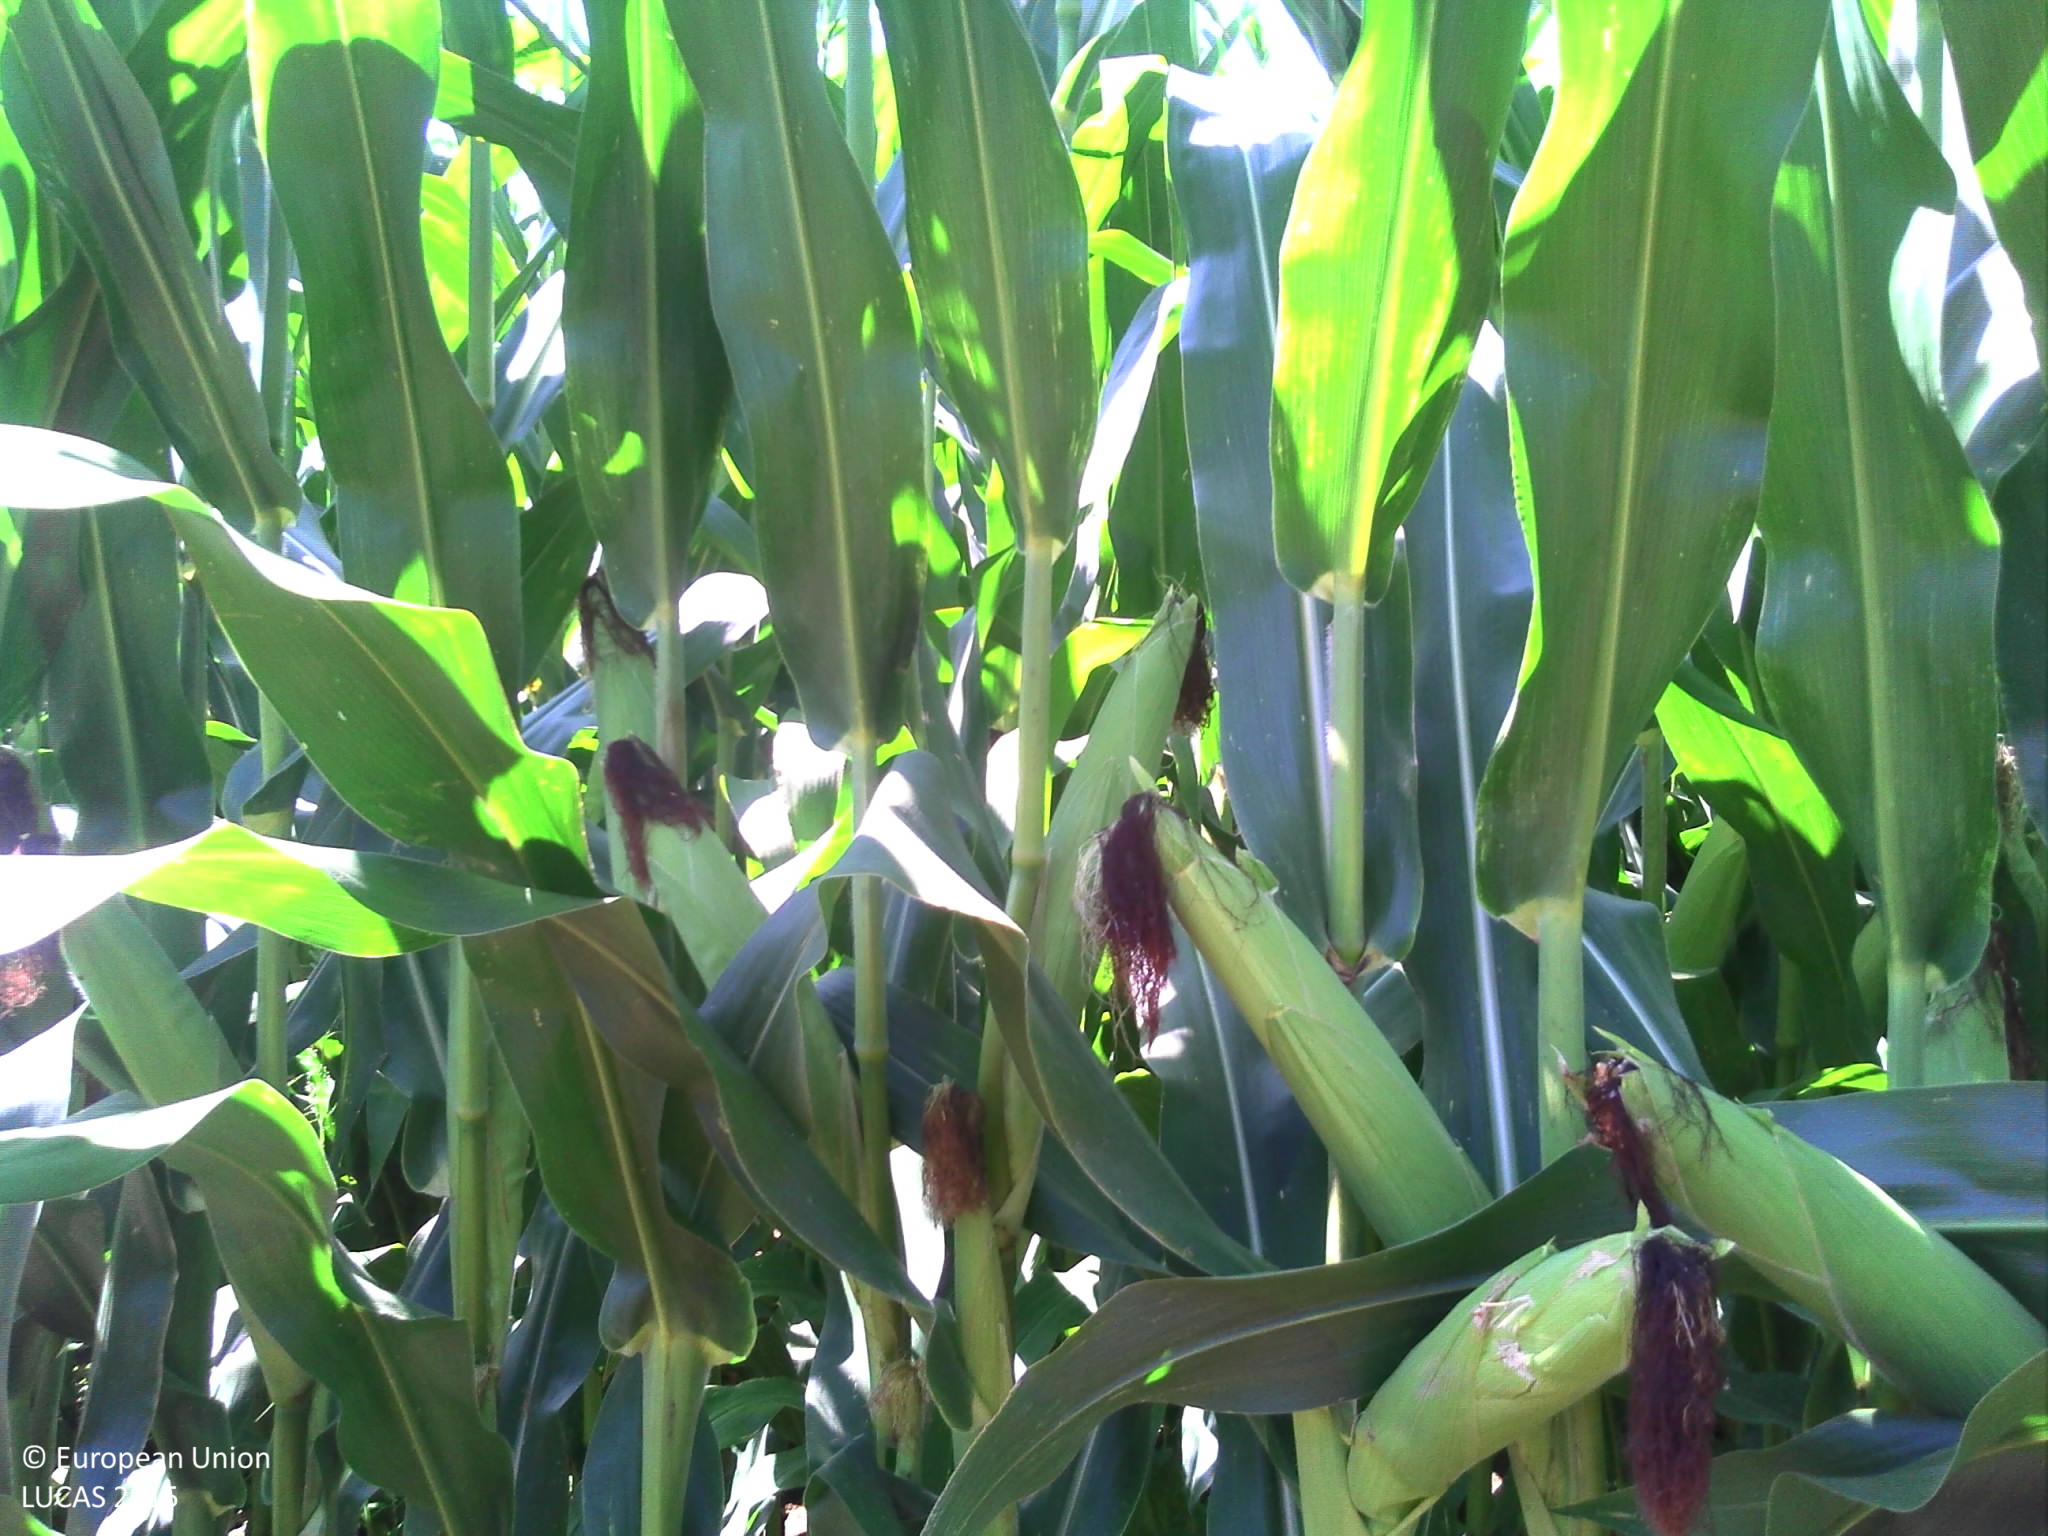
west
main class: Cropland
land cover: Maize
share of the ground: > 75 %
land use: Agriculture (excluding fallow land and kitchen gardens)
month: August
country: FR
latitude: 48.1845
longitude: 1.9841
